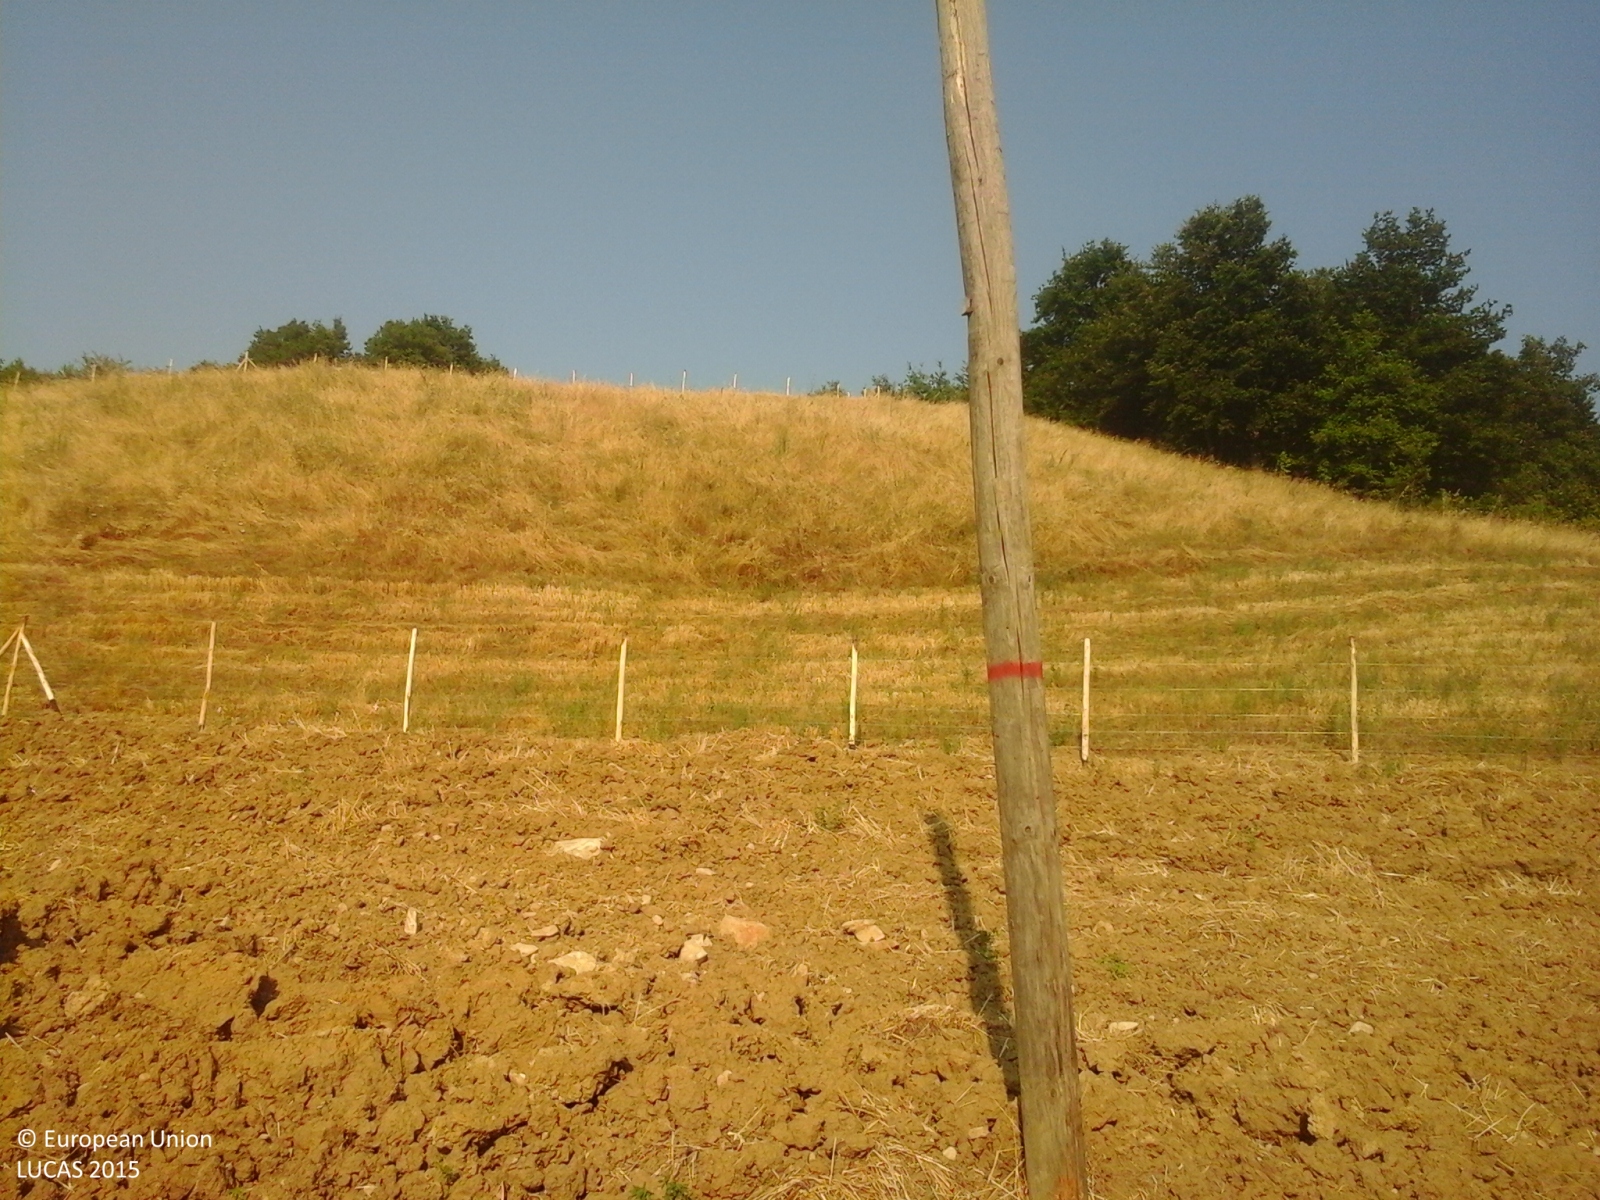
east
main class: Cropland
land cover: Mixed cereals for fodder
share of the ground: > 75 %
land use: Agriculture (excluding fallow land and kitchen gardens)
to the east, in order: Mixed cereals for fodder; Broadleaved woodland; Arable land (only in case pi); Grassland without tree/shrub cover; Broadleaved woodland; Arable land (only in case pi); Grass margins; Tracks; Abandoned hedges
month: August
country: IT
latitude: 42.4744
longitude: 13.7957
